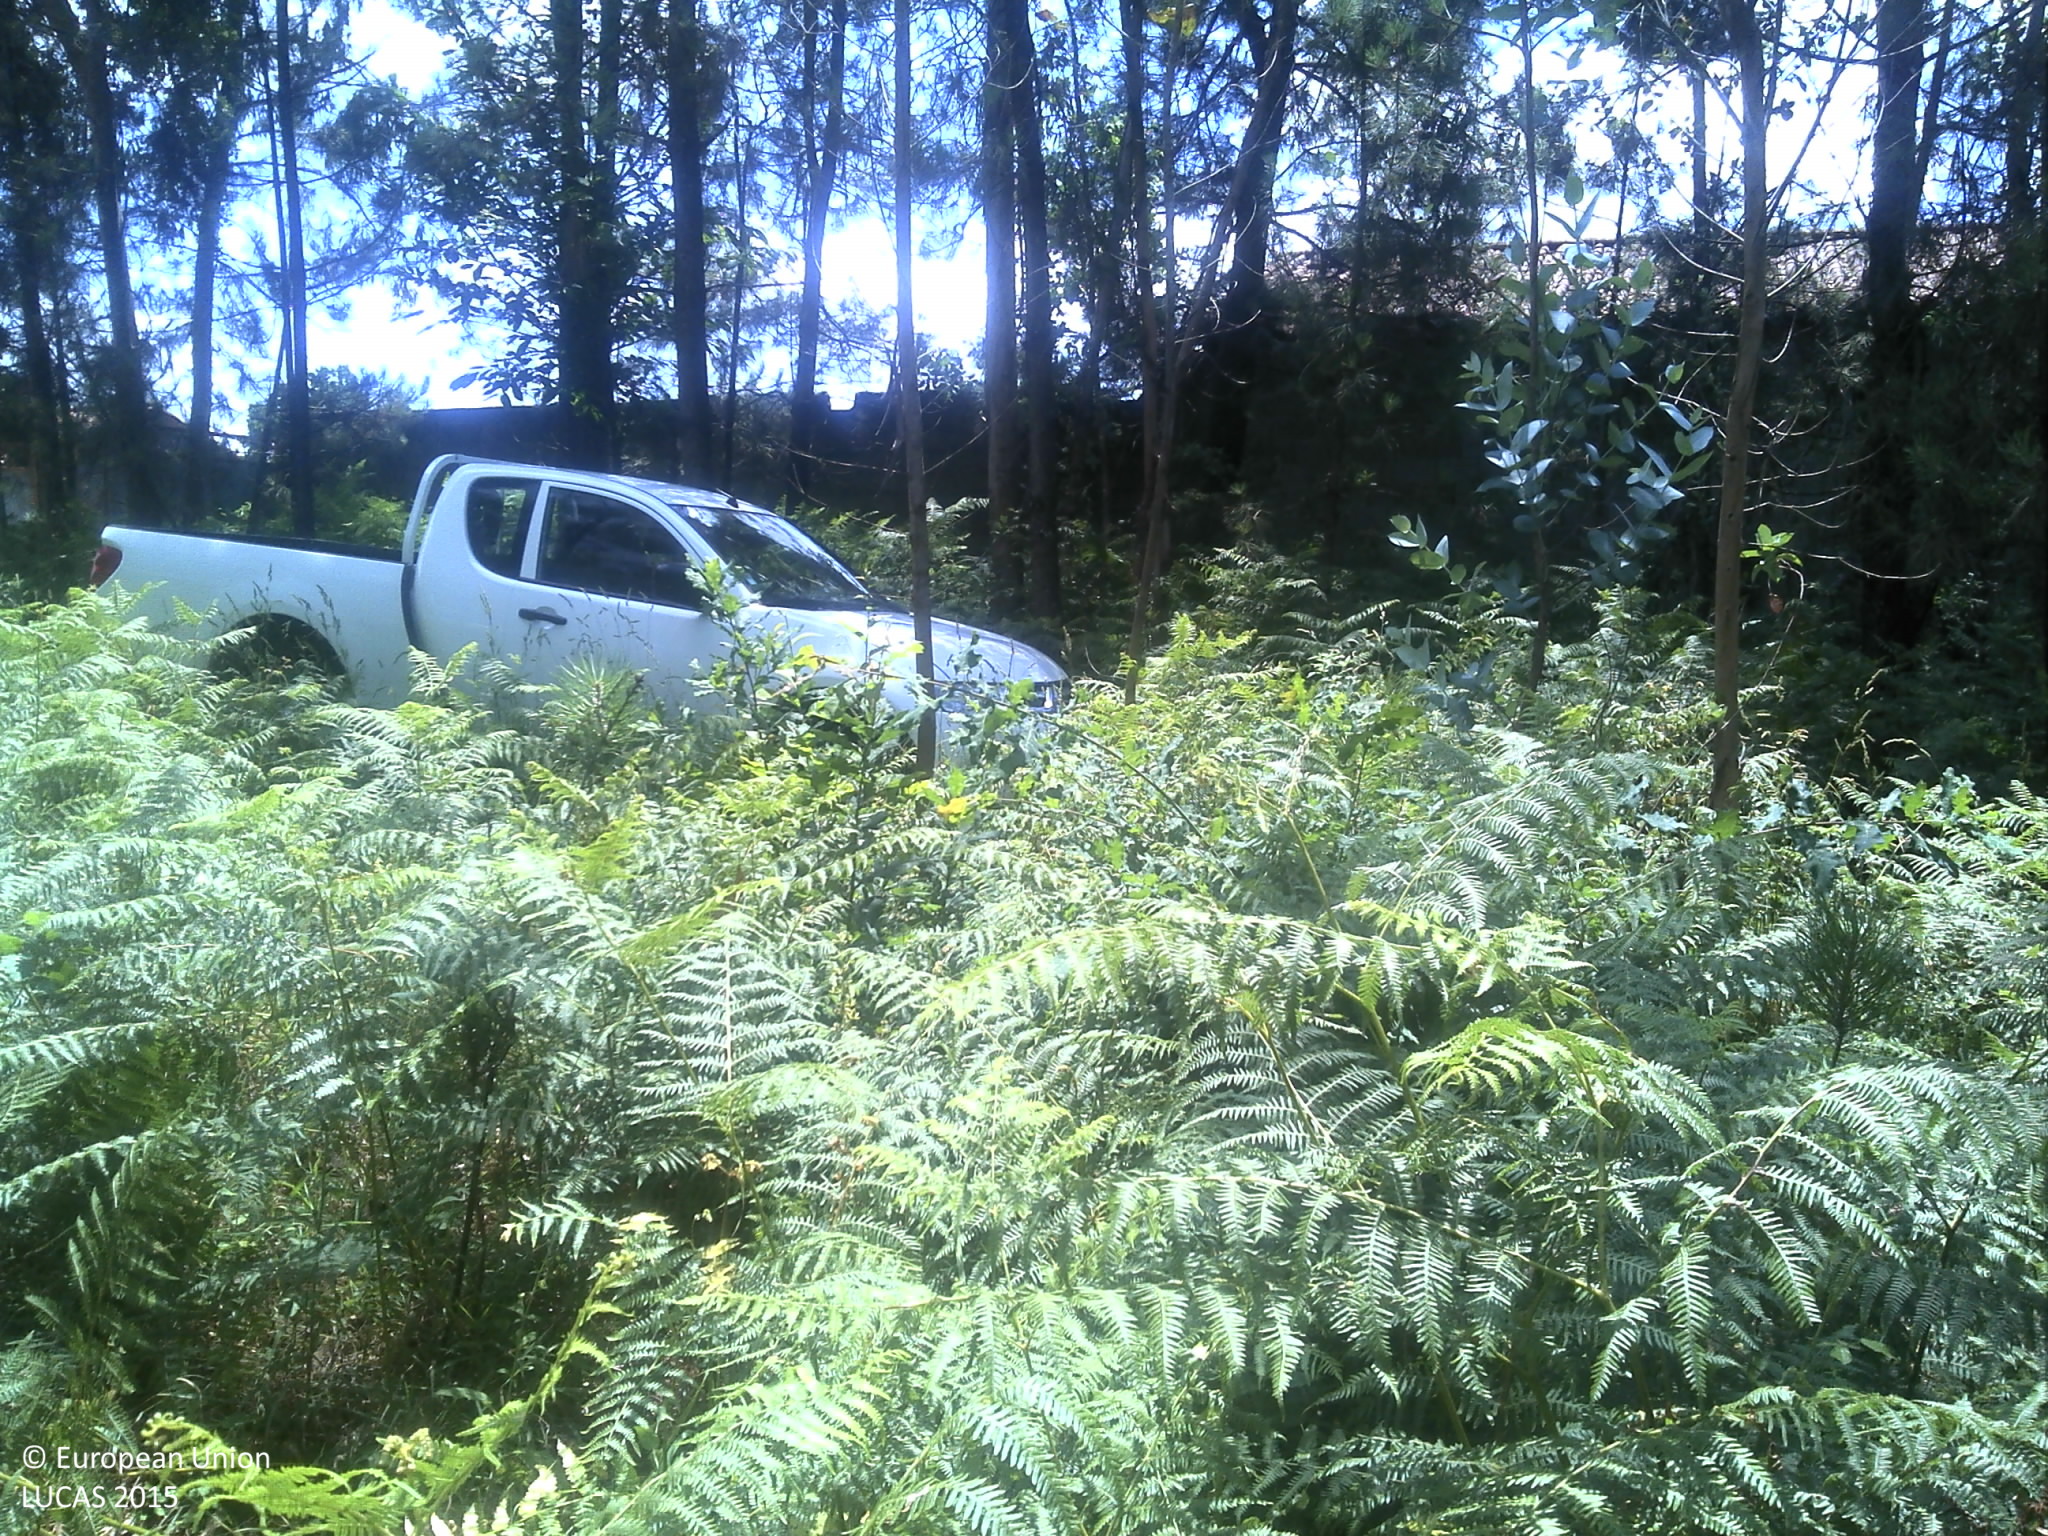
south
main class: Woodland
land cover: Pine dominated coniferous woodland
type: coniferous forest of the mediterranean region
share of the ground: 50 - 75 %
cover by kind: coniferous forest trees 70 %, shrubs 20 %, herbaceous plants 5 %, unconsolidated bare surface 5 %
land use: Forestry
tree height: > 5 m
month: June
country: PT
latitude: 41.5971
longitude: -8.5999
